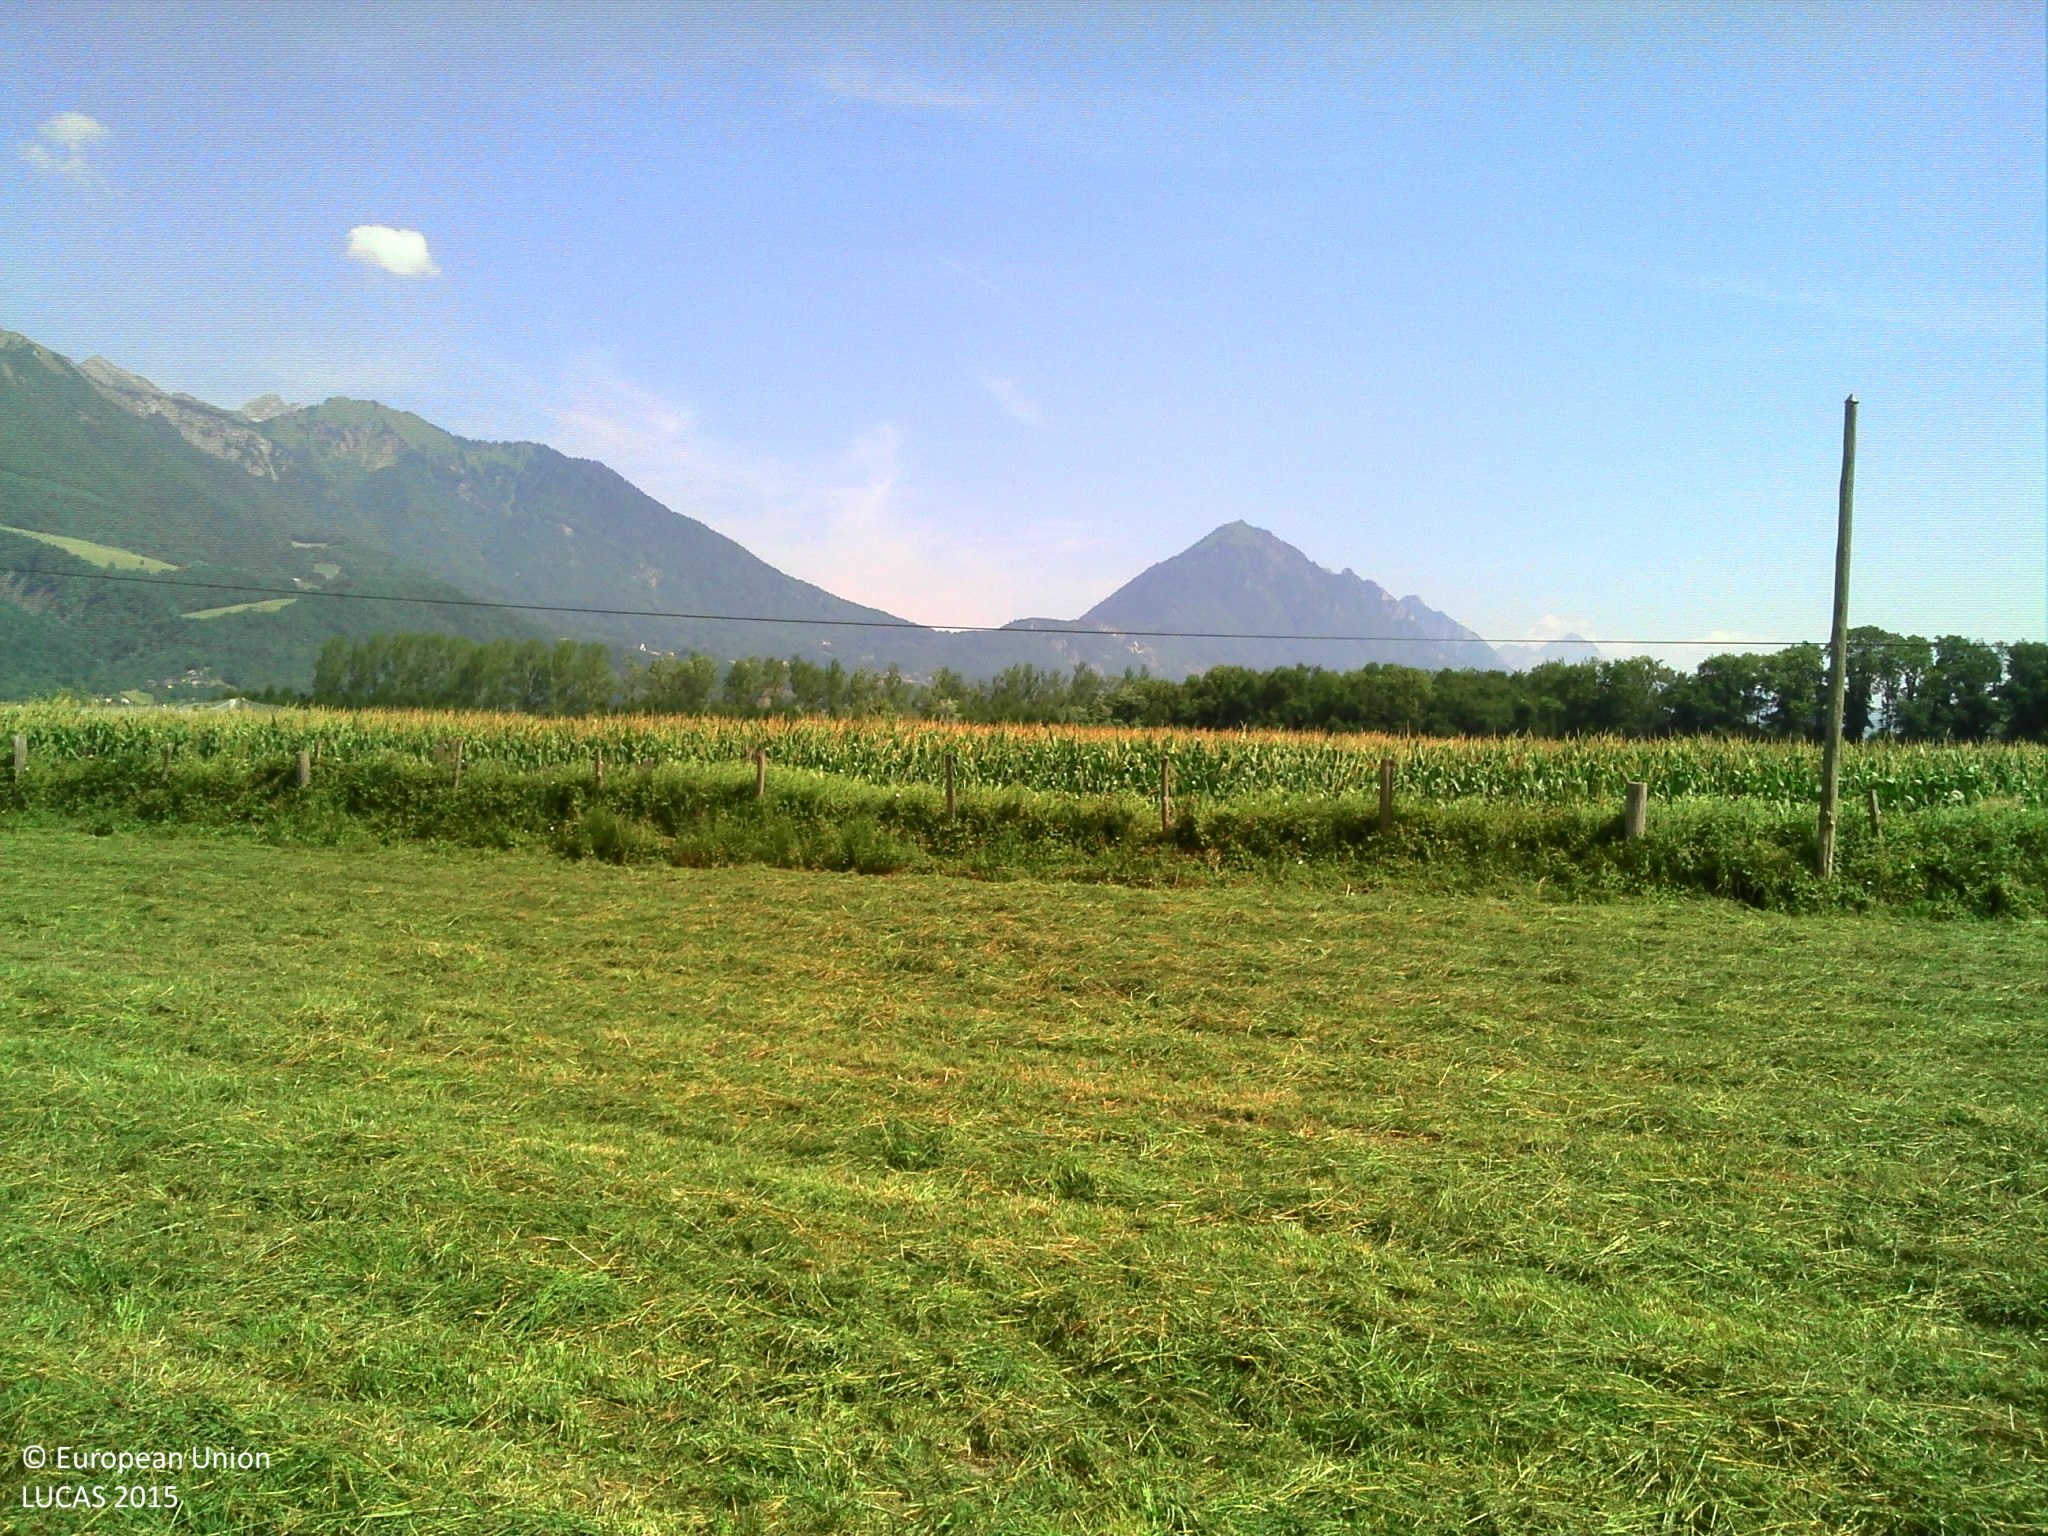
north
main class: Grassland
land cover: Grassland without tree/shrub cover
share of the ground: > 75 %
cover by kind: herbaceous plants 100 %
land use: Agriculture (excluding fallow land and kitchen gardens)
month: July
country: FR
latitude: 45.6019
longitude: 6.2993
